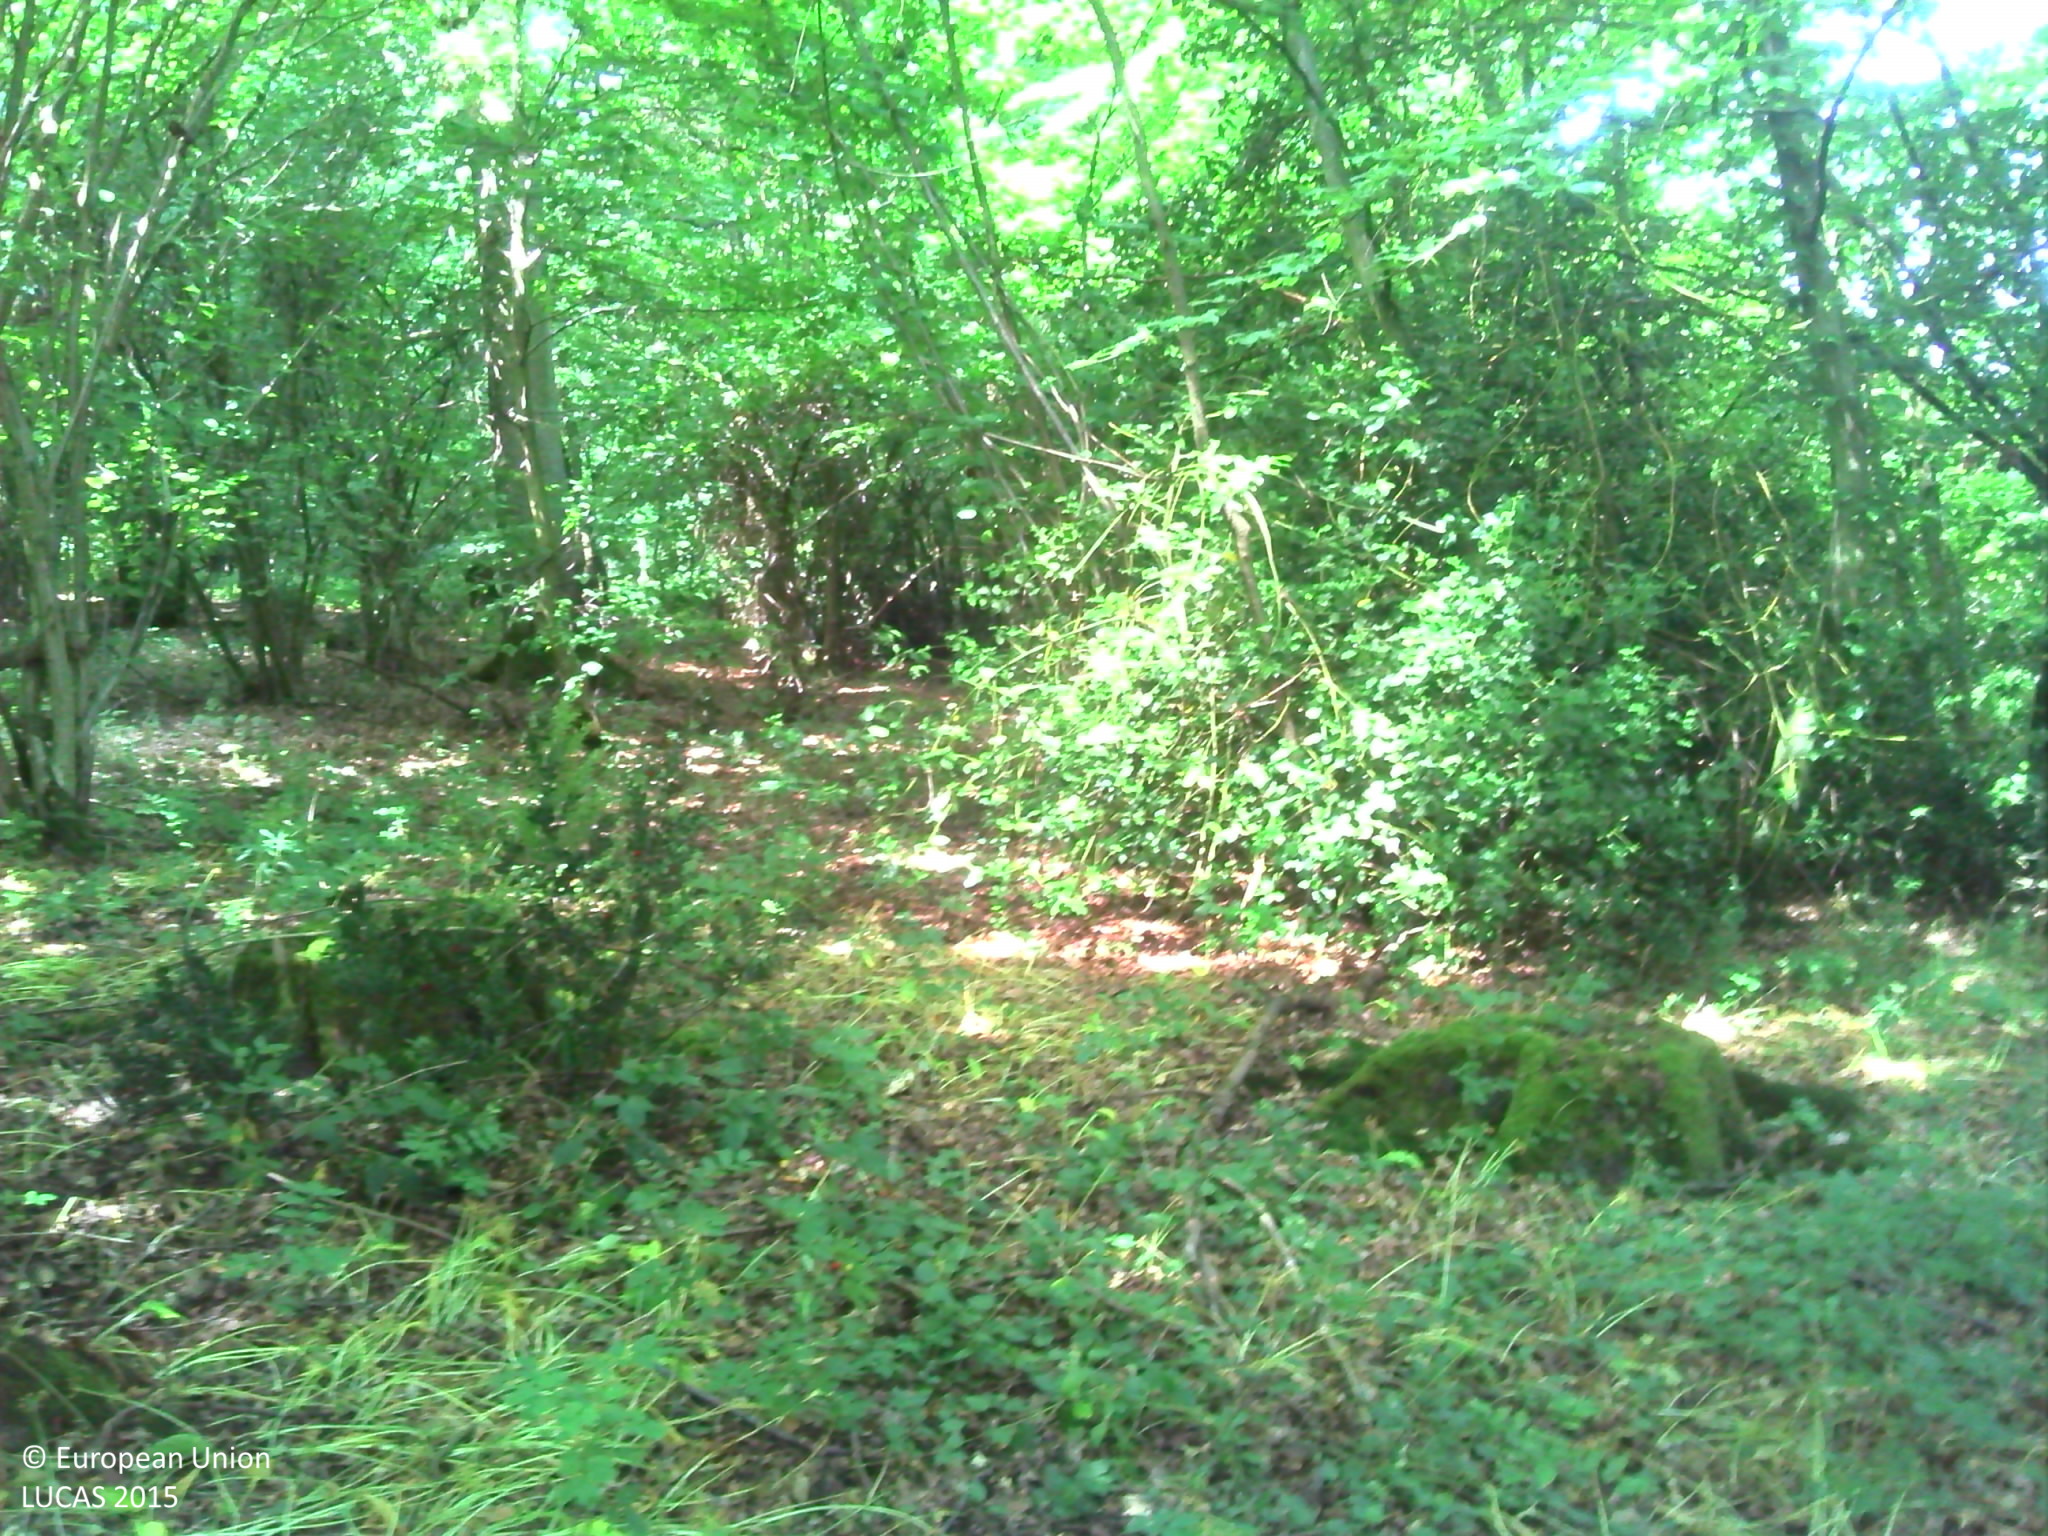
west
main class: Woodland
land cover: Broadleaved woodland
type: mesophytic deciduous forest
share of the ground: > 75 %
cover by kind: broadleaved forest trees 80 %, herbaceous plants 10 %, lichens and mosses 5 %, consolidated bare surface 5 %
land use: Forestry
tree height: > 5 m
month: June
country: FR
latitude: 49.1887
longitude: 1.1568
